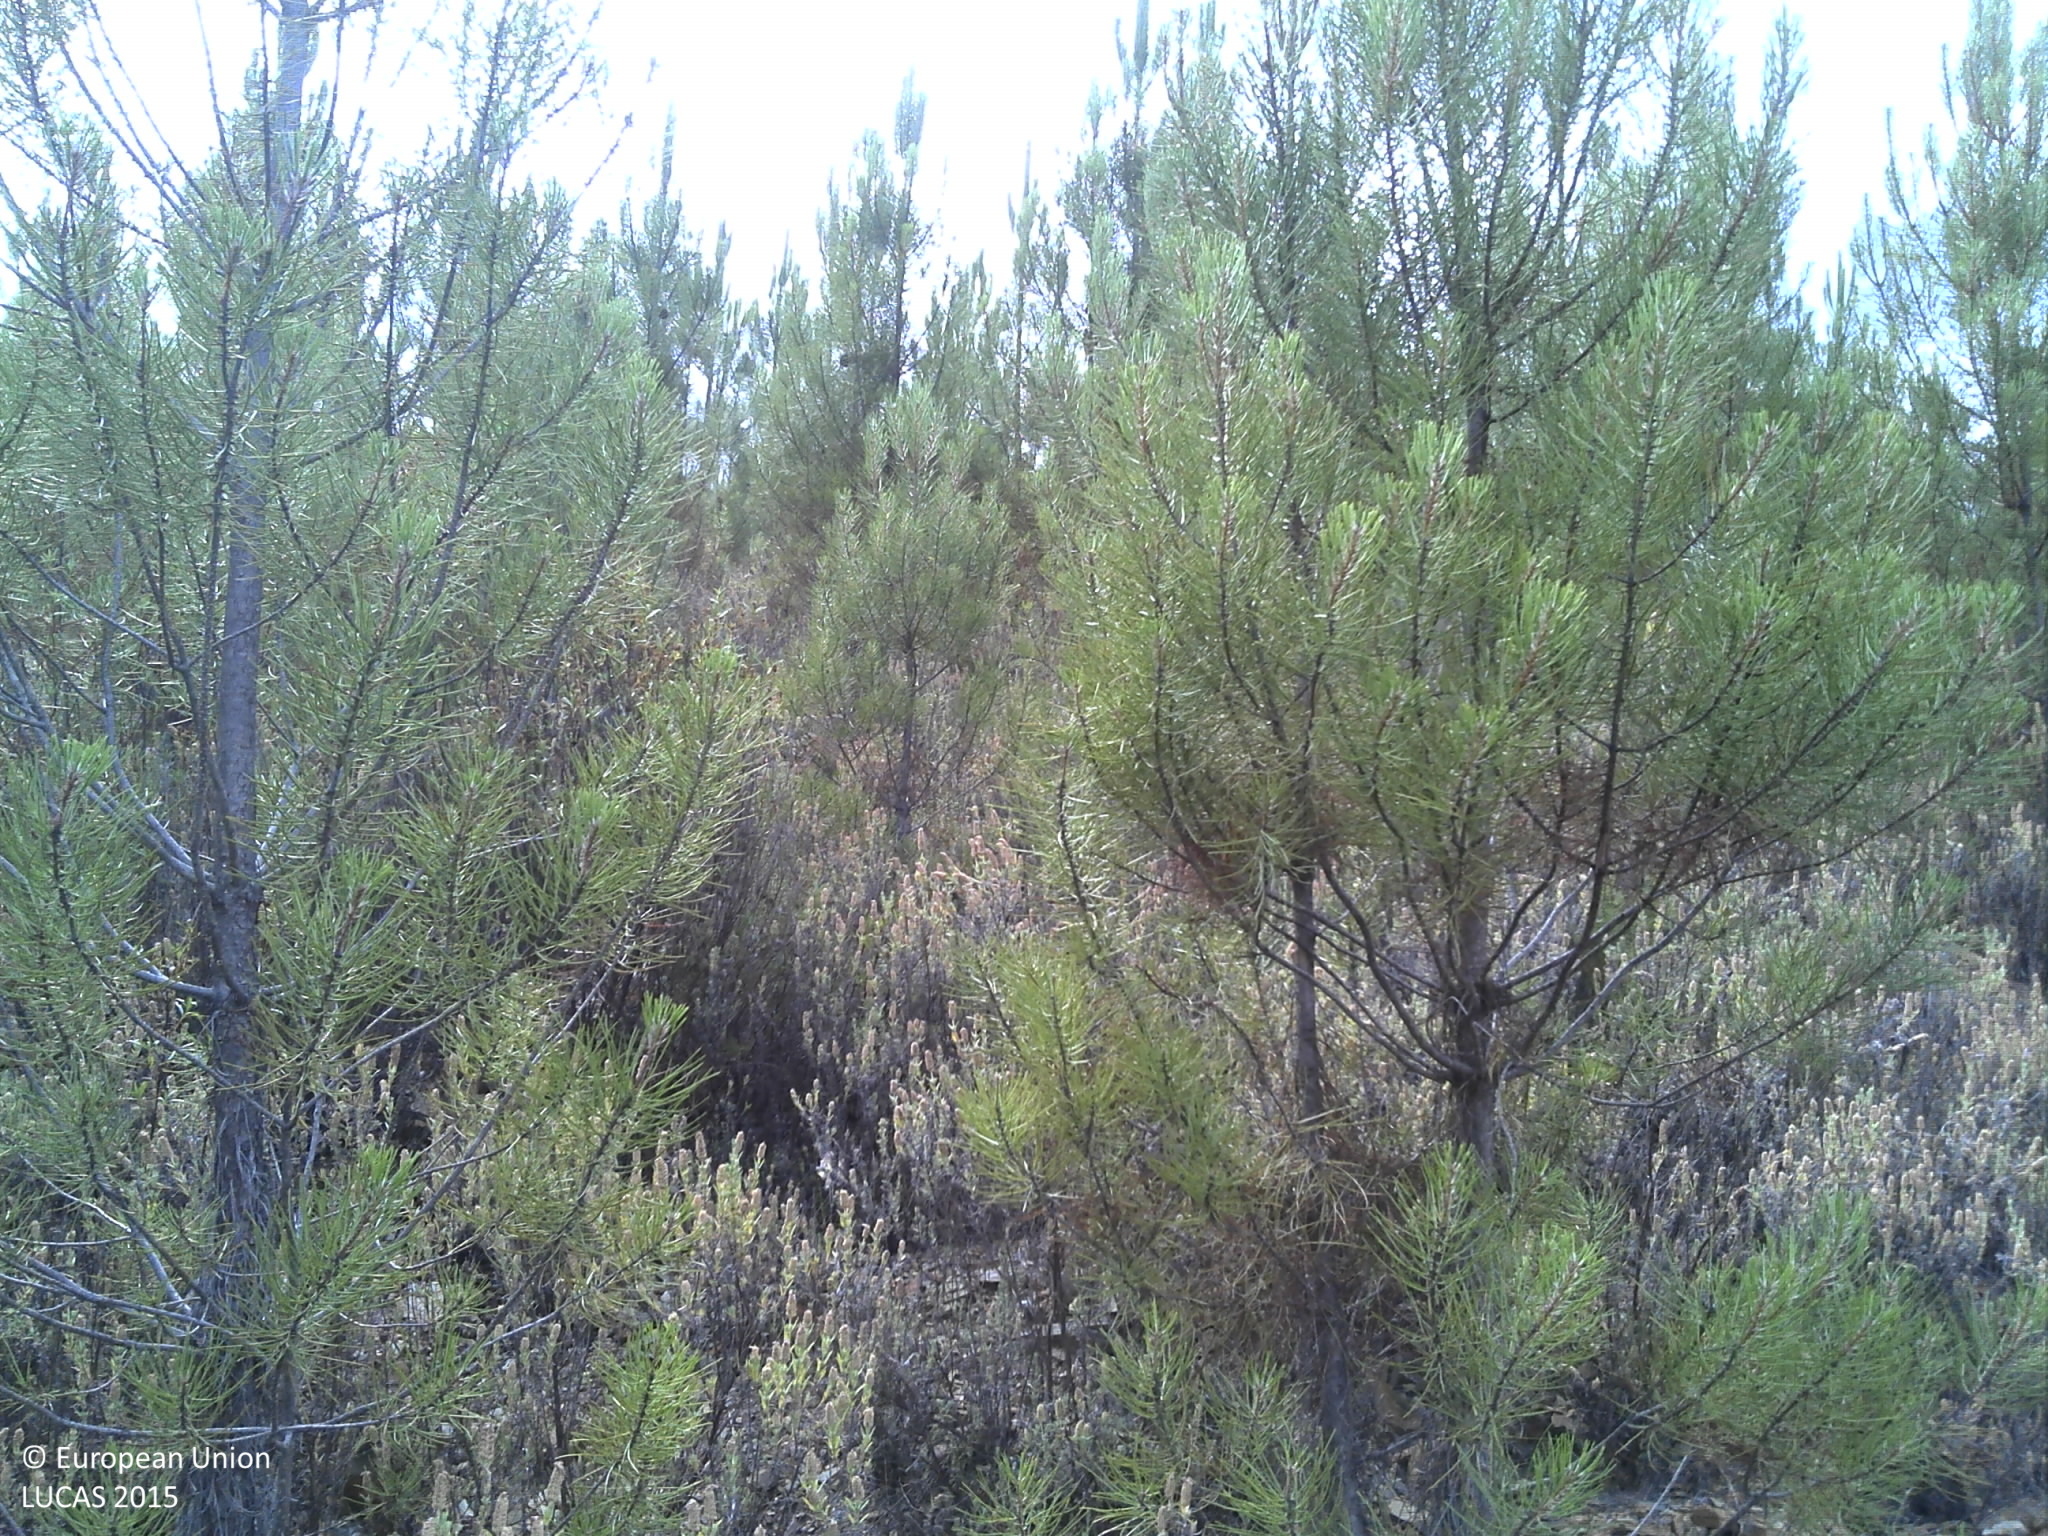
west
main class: Woodland
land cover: Pine dominated coniferous woodland
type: coniferous forest of the mediterranean region
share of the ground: 10 - 25 %
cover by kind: shrubs 60 %, unconsolidated bare surface 25 %, coniferous forest trees 15 %
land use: Forestry
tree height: < 5 m
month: July
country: PT
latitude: 39.6679
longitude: -8.0504
